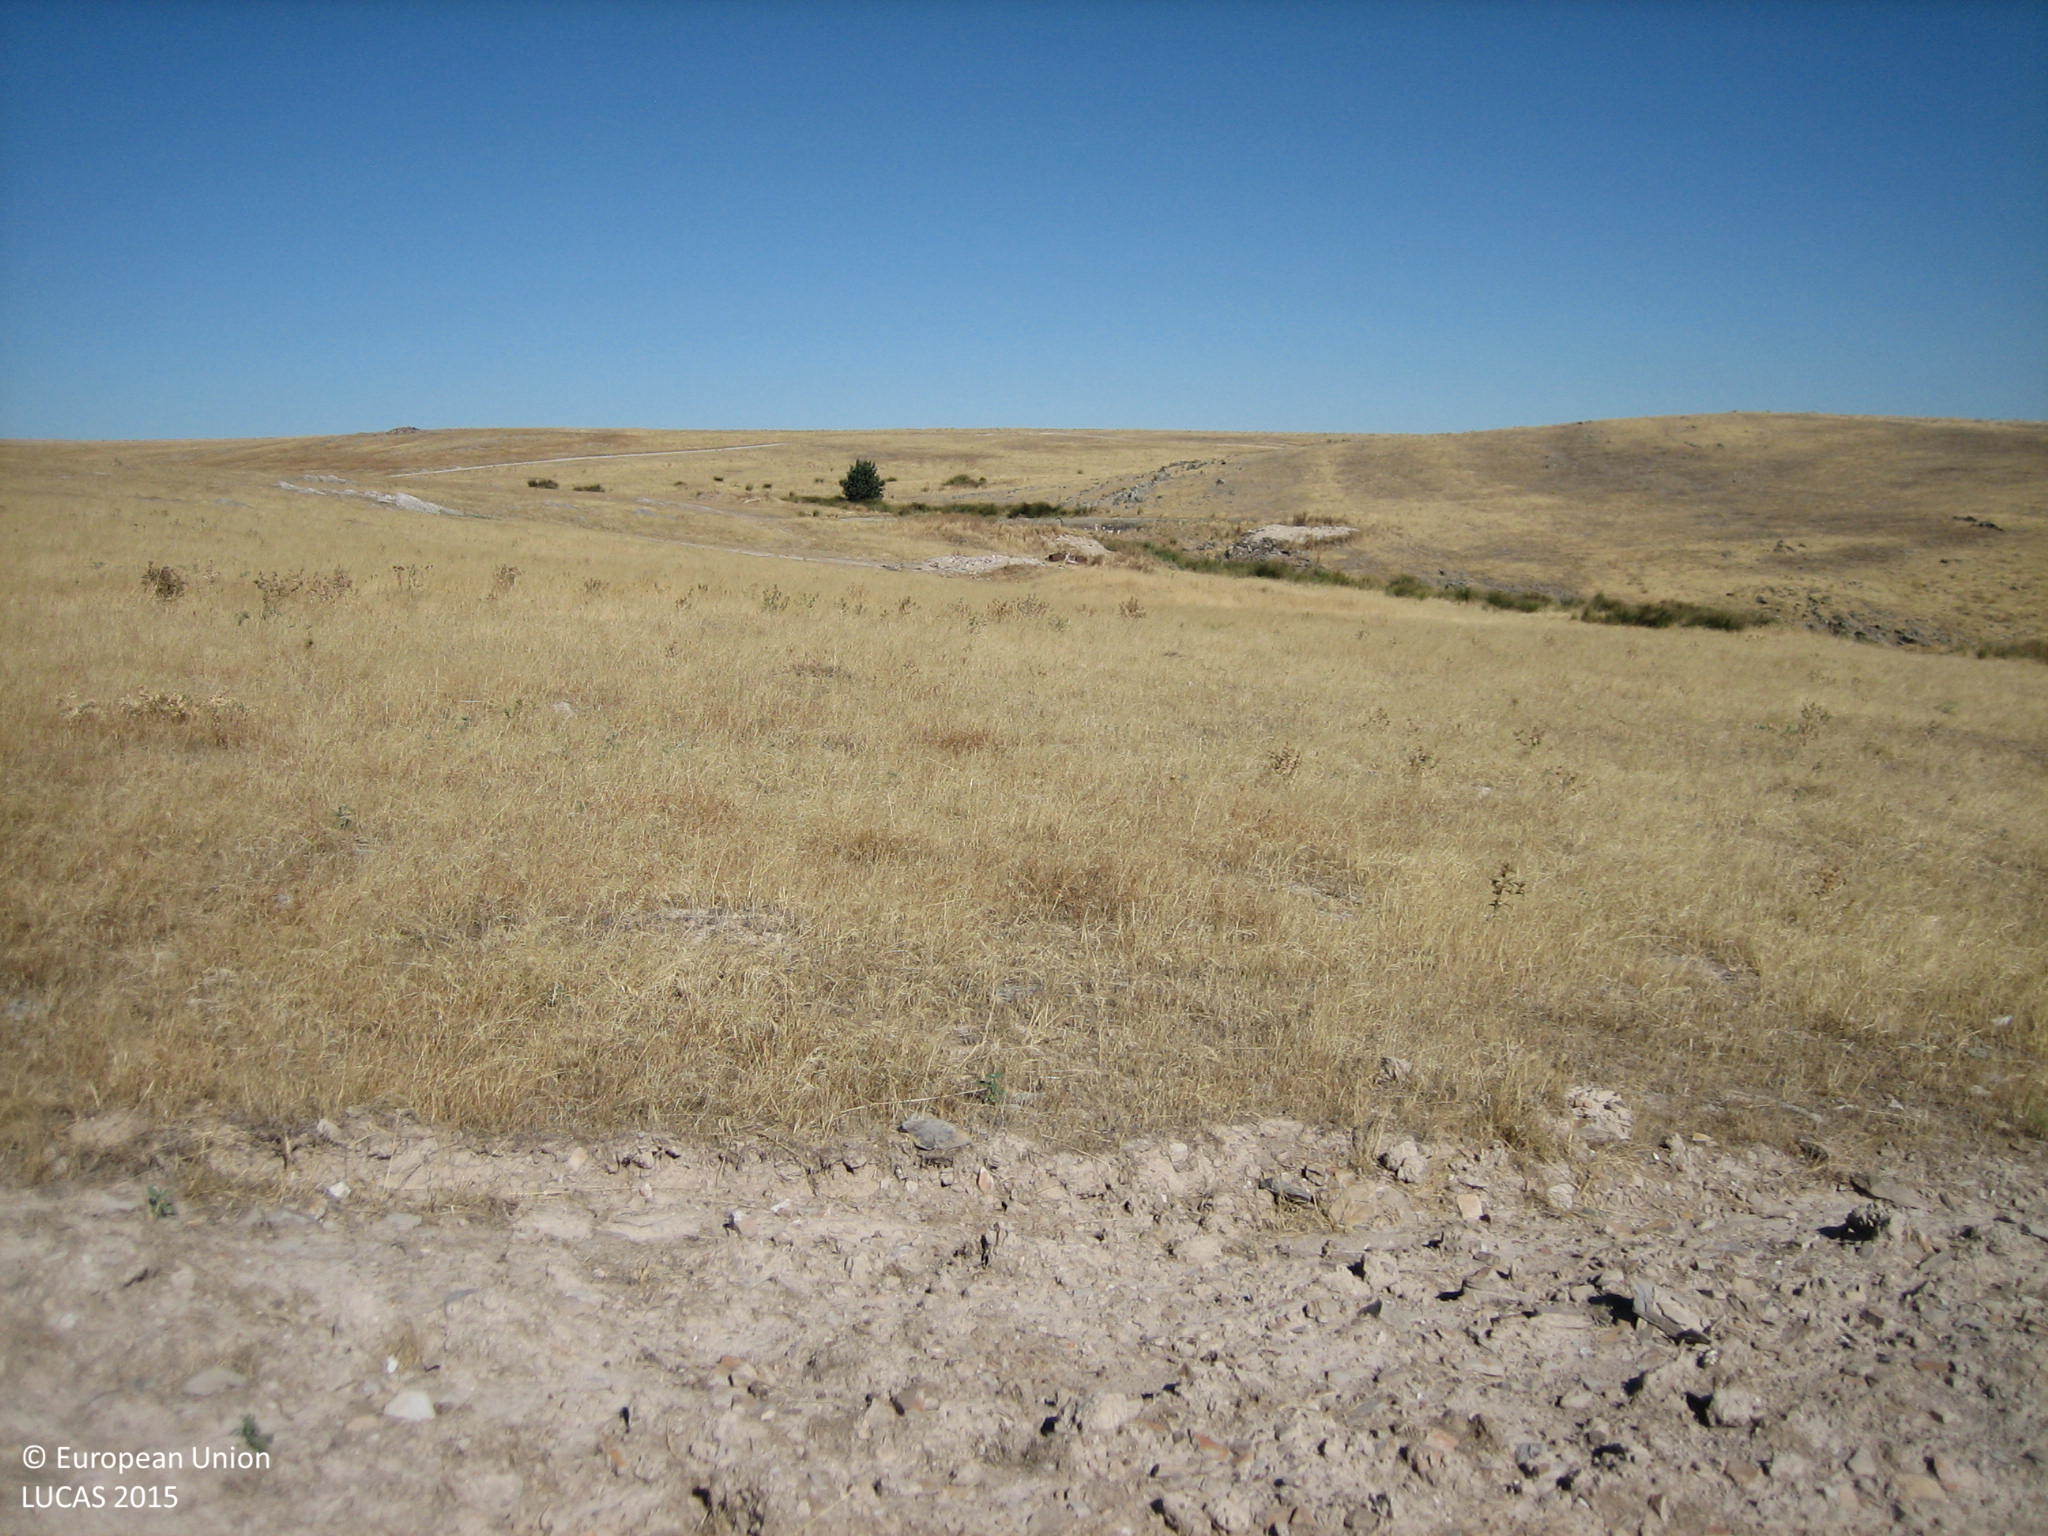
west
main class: Grassland
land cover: Spontaneously vegetated surfaces
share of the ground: > 75 %
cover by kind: herbaceous plants 100 %
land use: Fallow land
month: July
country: ES
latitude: 38.3710
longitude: -6.1256
